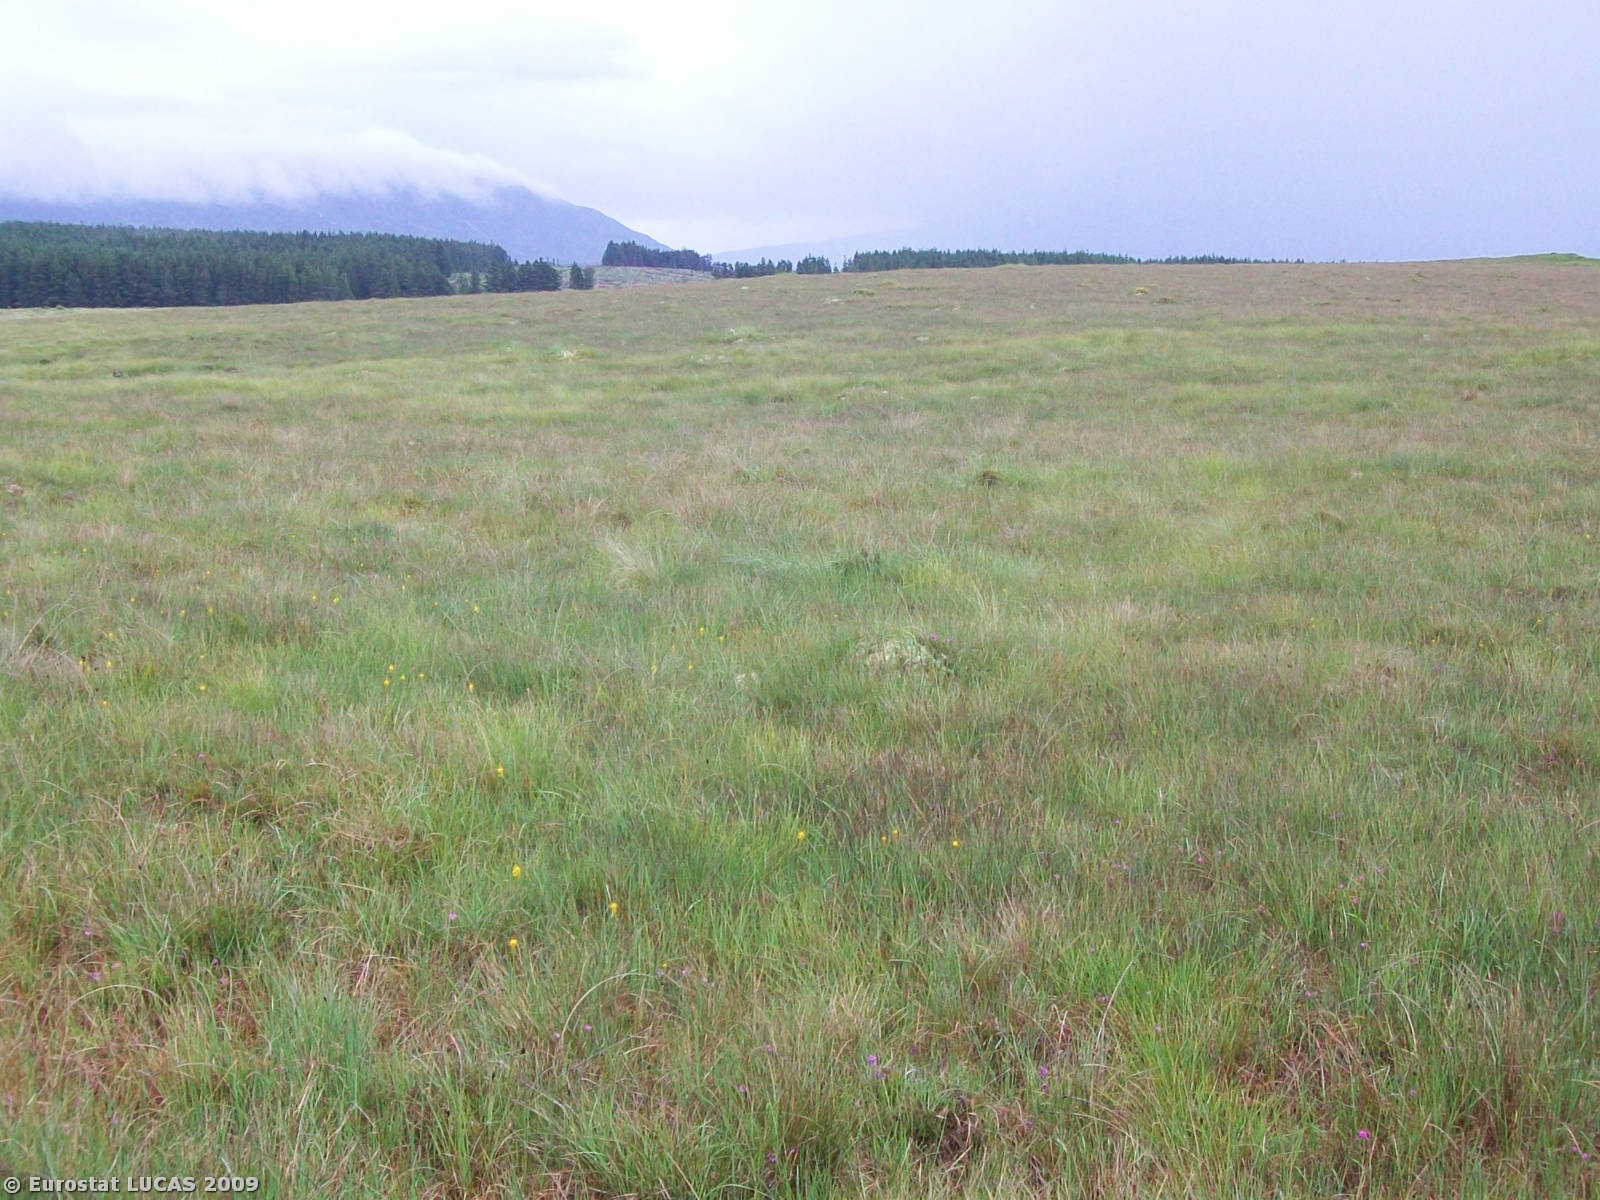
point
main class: Wetlands
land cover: Peatbogs
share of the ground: > 75 %
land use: Unused
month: July
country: IE
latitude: 53.9955
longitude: -9.7522
